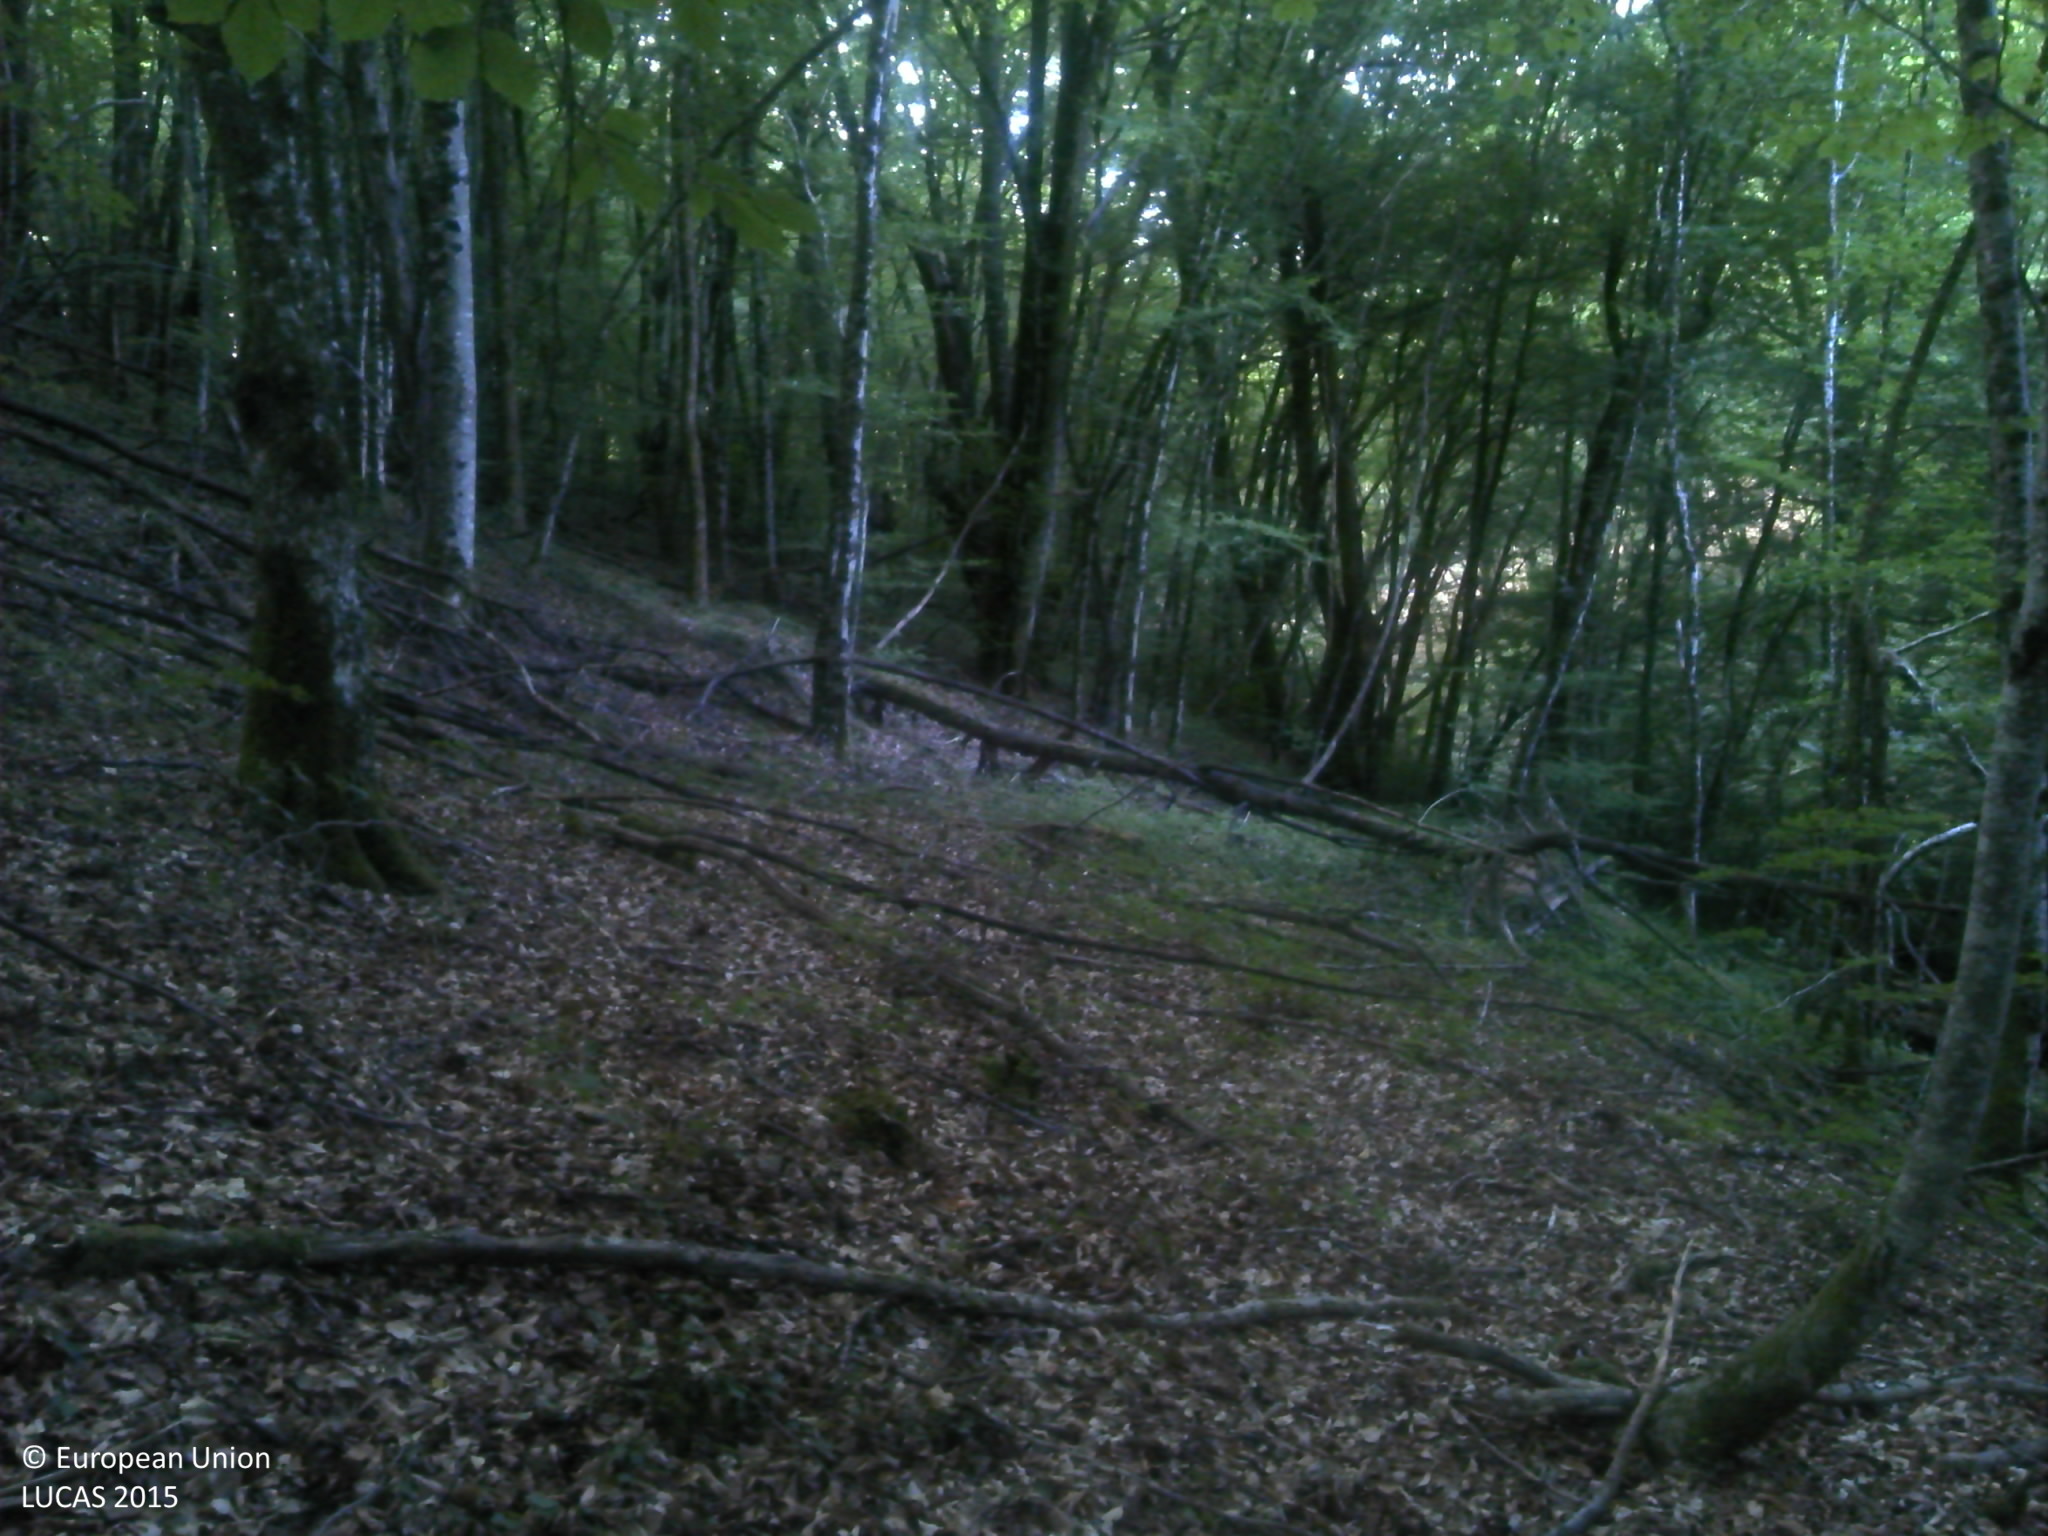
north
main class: Woodland
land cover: Broadleaved woodland
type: acidophilous oak and oak-birch forest
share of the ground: > 75 %
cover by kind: broadleaved forest trees 55 %, unconsolidated bare surface 30 %, lichens and mosses 10 %, herbaceous plants 5 %
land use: Forestry
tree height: > 5 m
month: July
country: FR
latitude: 45.2139
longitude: 1.7066
